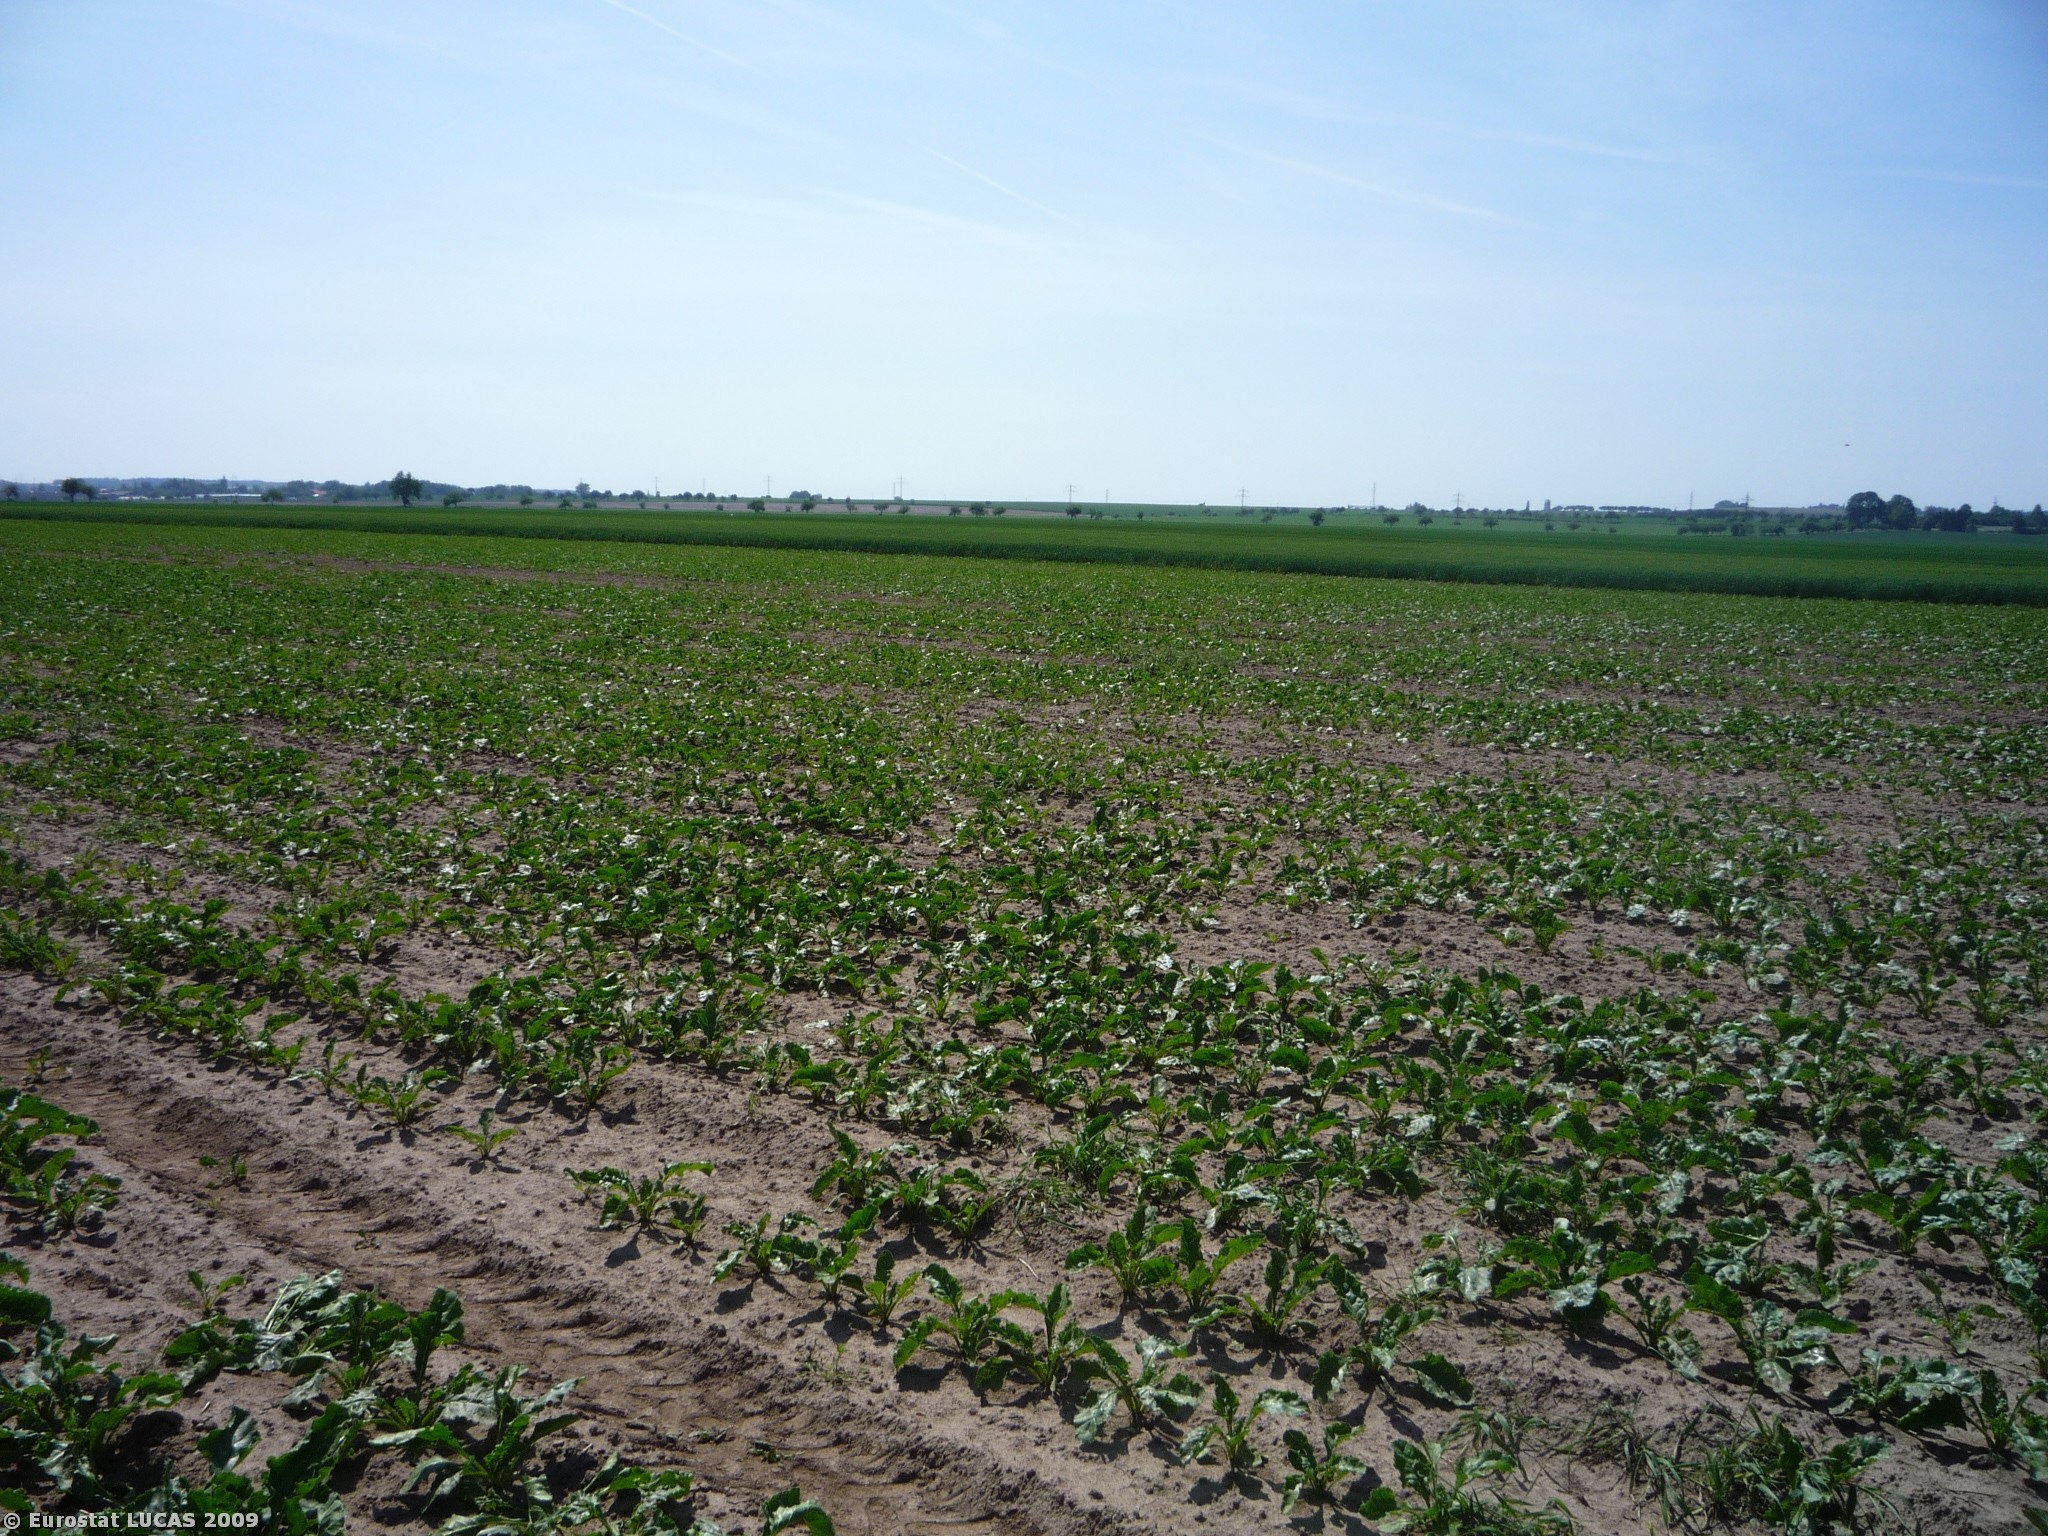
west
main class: Cropland
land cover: Sugar beet
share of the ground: 10 - 25 %
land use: Agriculture (excluding fallow land and kitchen gardens)
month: May
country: CZ
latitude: 50.2710
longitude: 15.7996
